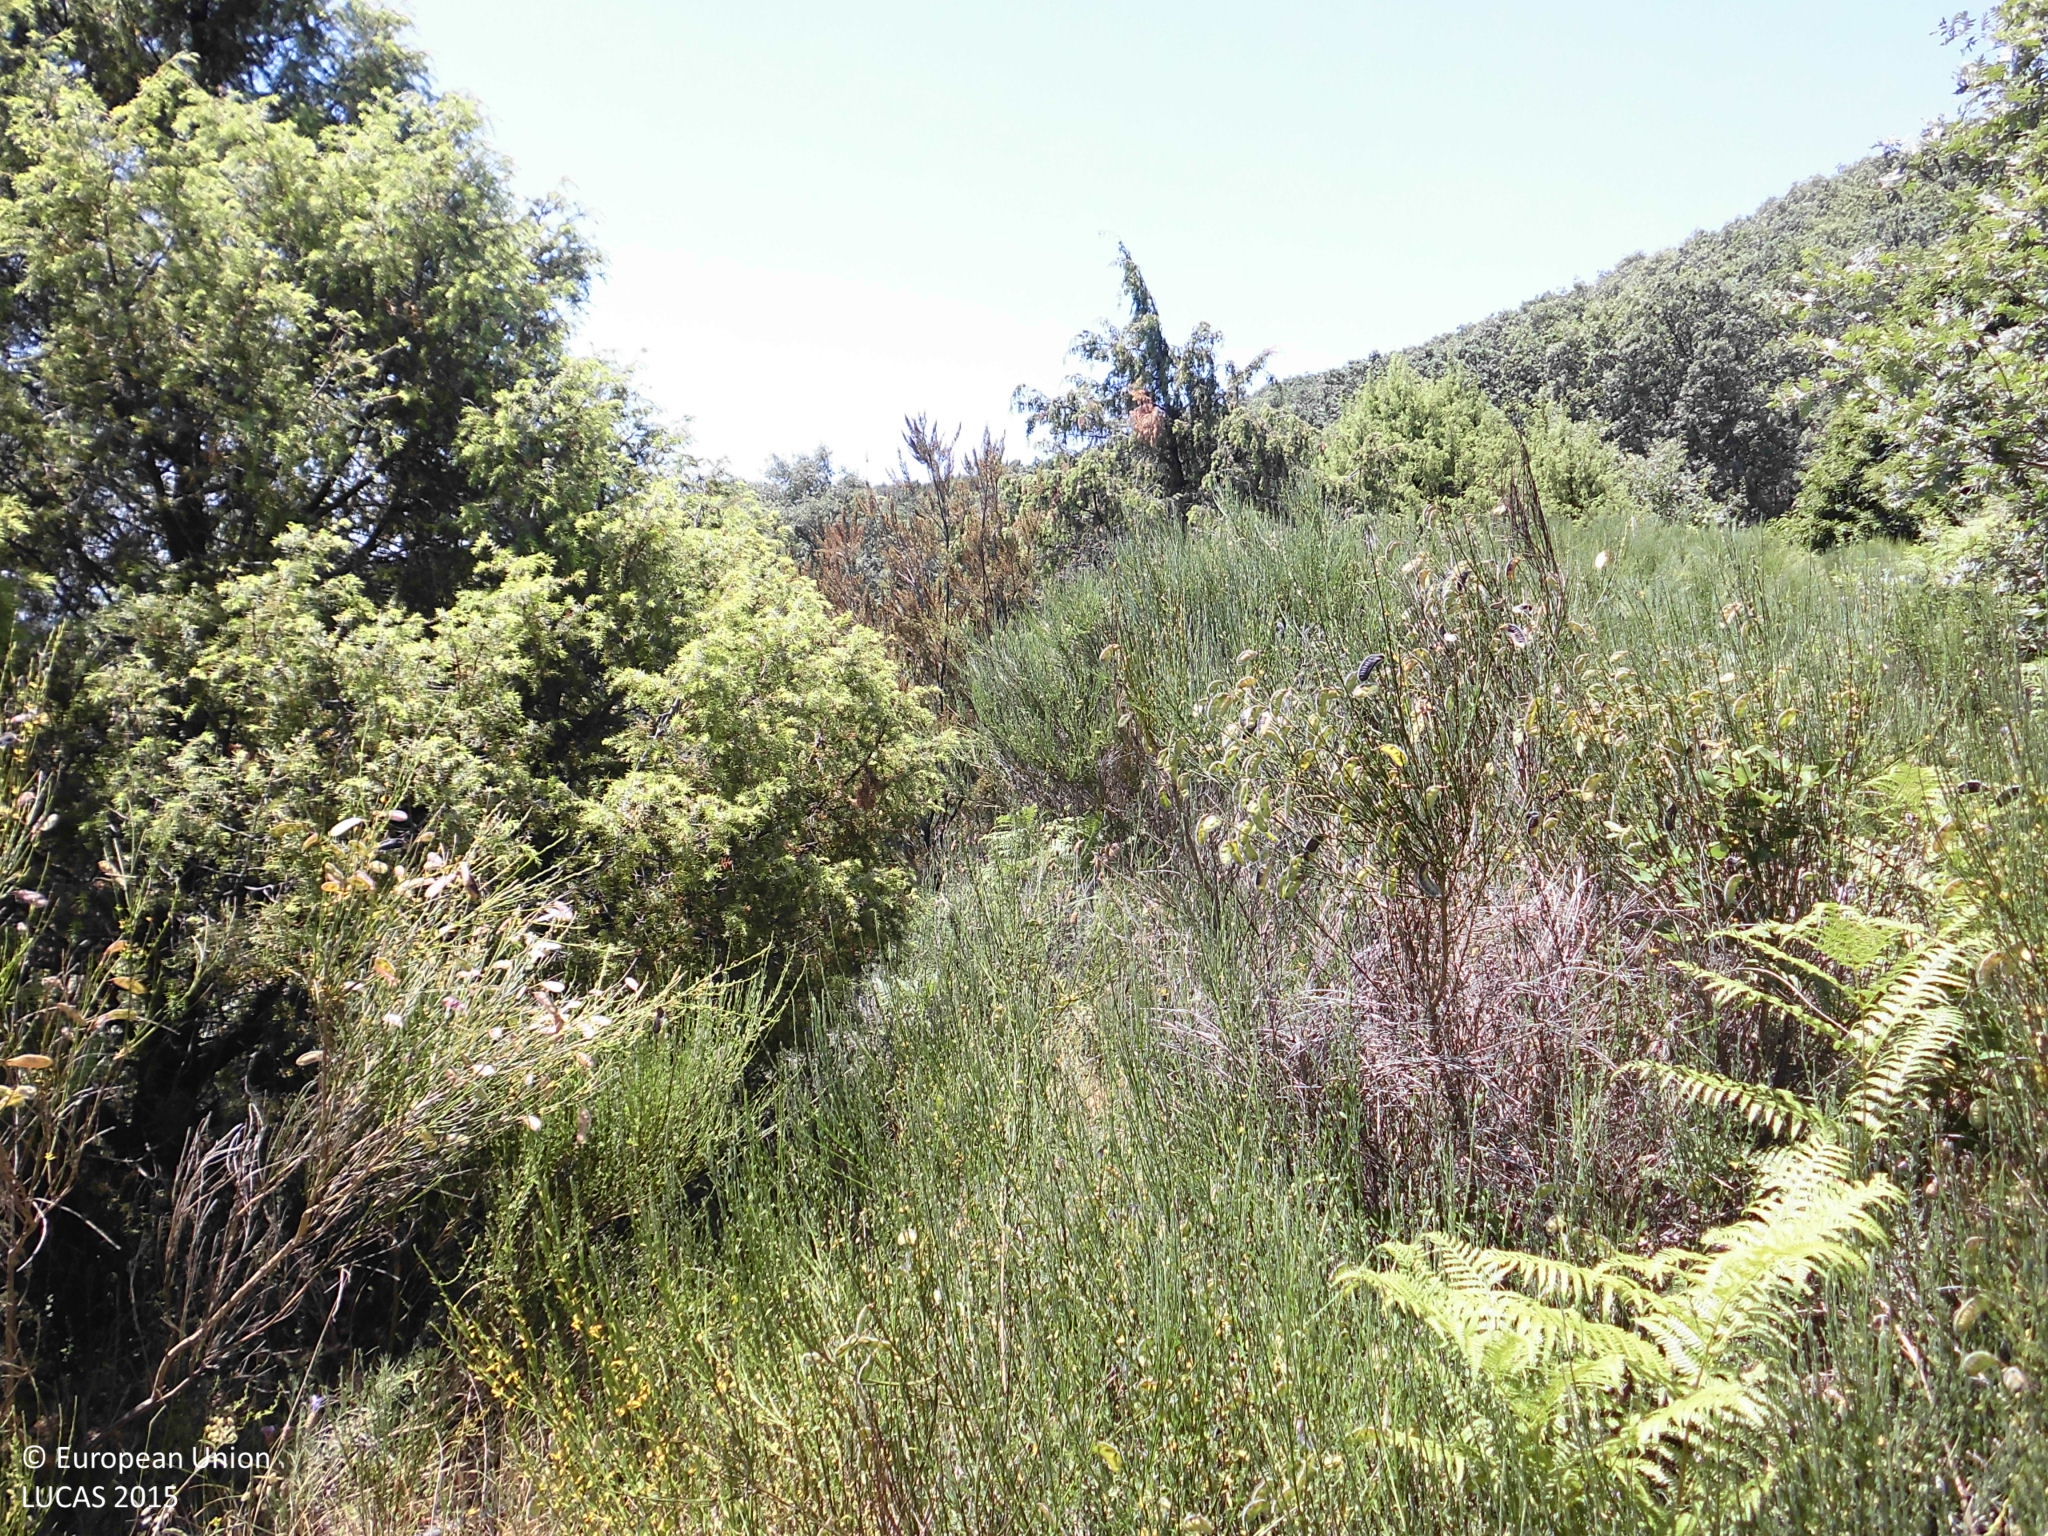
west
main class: Woodland
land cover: Broadleaved woodland
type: thermophilous deciduous forest
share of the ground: 10 - 25 %
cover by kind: shrubs 90 %, broadleaved forest trees 10 %
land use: Forestry
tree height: > 5 m
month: June
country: ES
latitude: 40.1309
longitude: -5.4942
